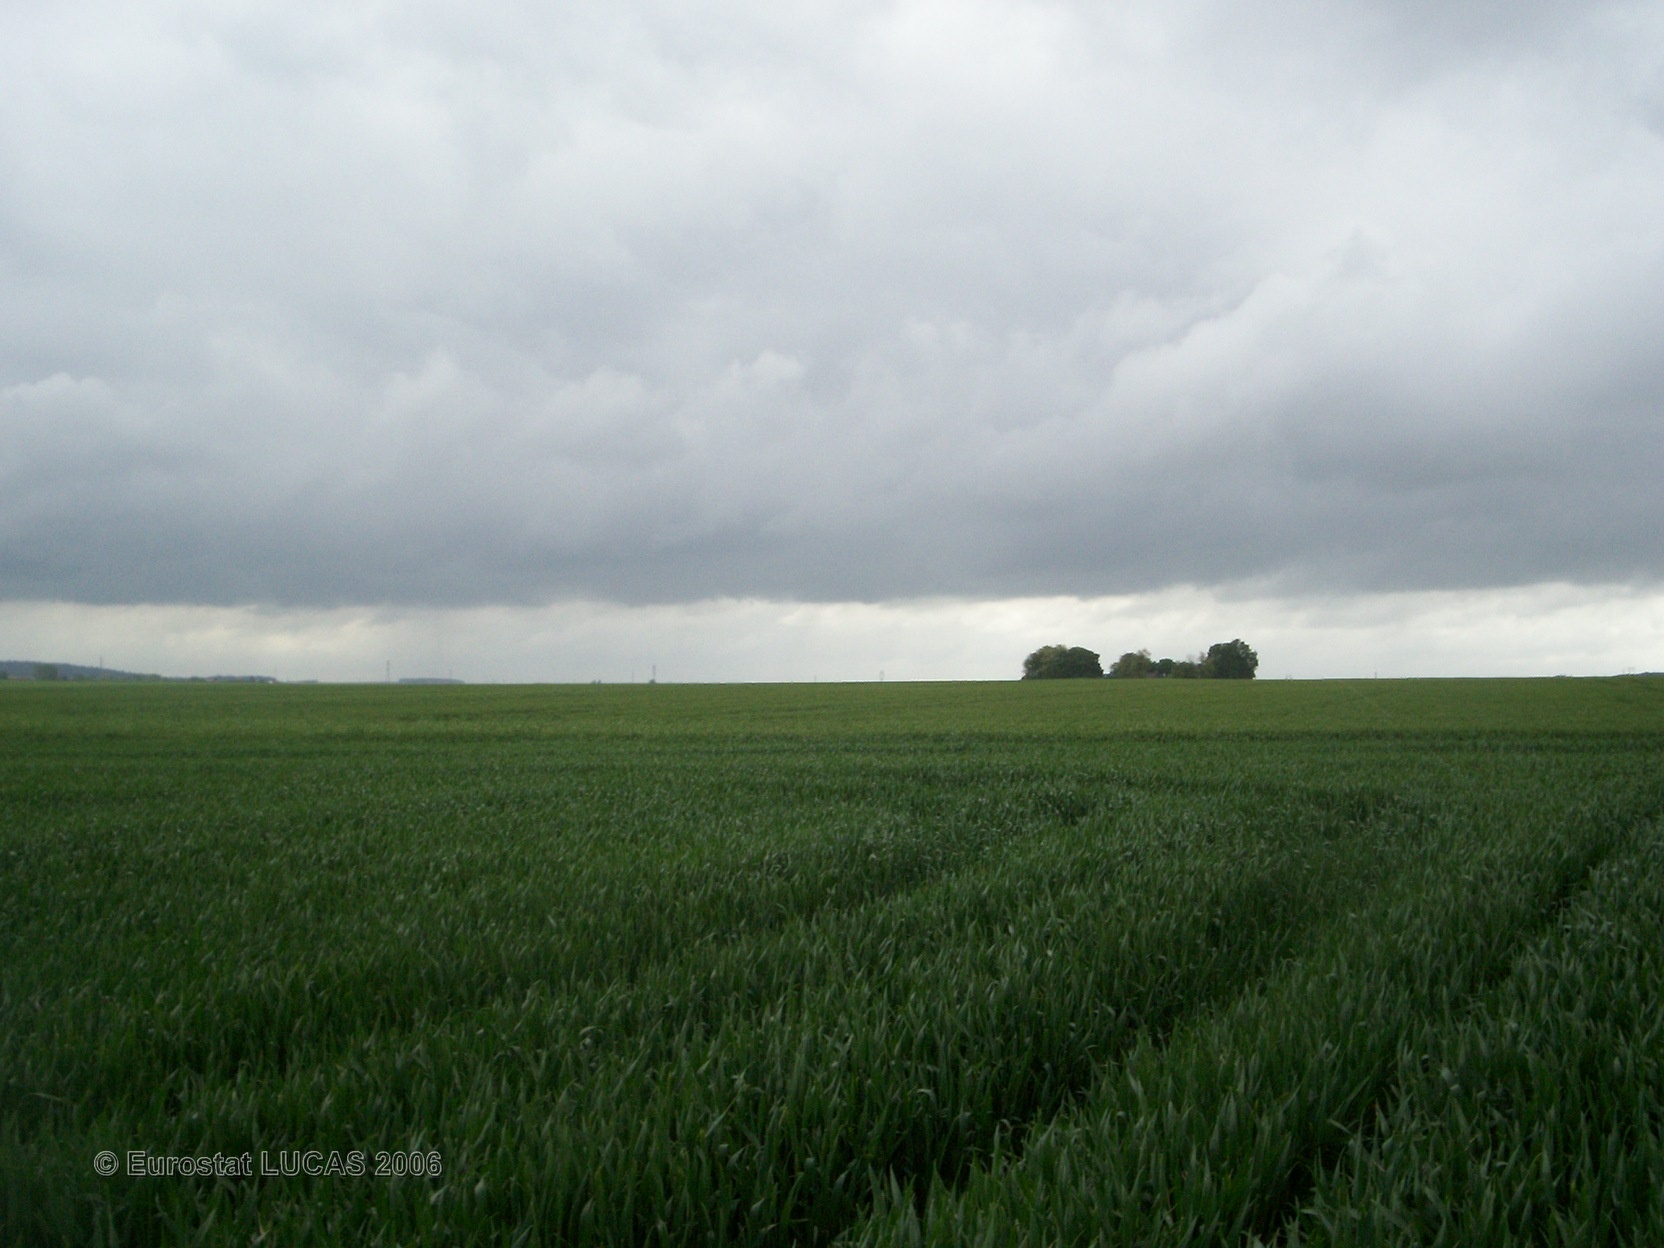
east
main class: Cropland
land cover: Common wheat
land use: Agriculture (excluding fallow land and kitchen gardens)
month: May
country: FR
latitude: 49.2276
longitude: 2.6978
